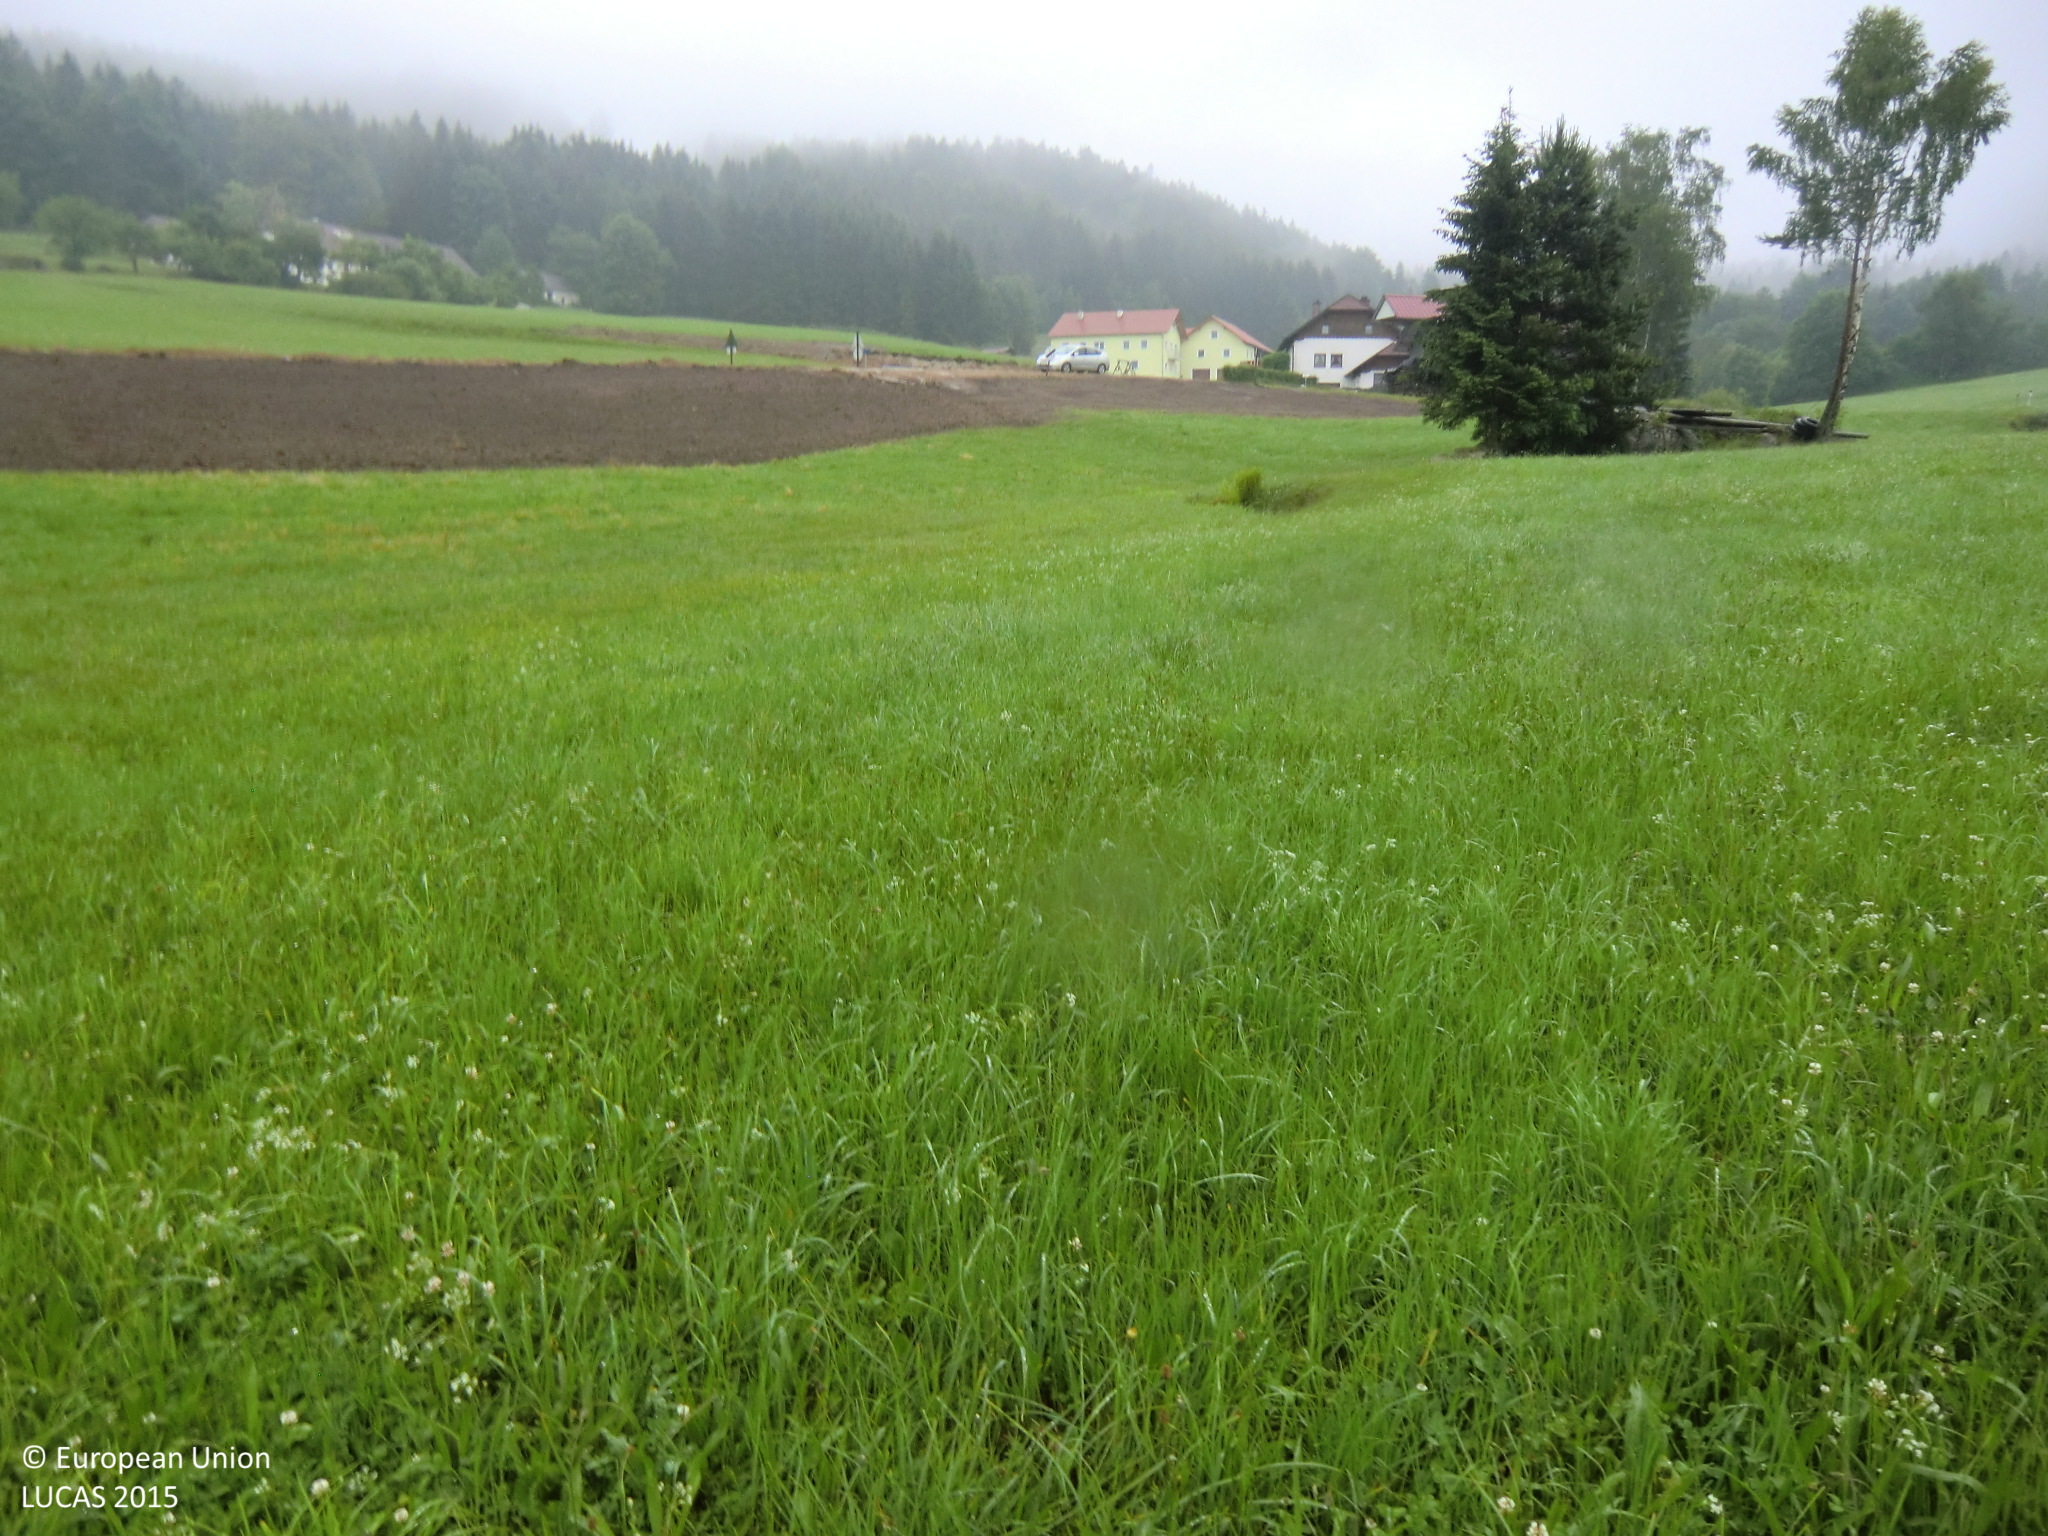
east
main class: Grassland
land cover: Grassland without tree/shrub cover
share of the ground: > 75 %
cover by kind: herbaceous plants 100 %
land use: Agriculture (excluding fallow land and kitchen gardens)
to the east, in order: Grassland without tree/shrub cover; Fences; Grassland without tree/shrub cover; Other bare soil; Paved roads, cycling and walking lanes; Grassland without tree/shrub cover; Paved roads, cycling and walking lanes; Grassland without tree/shrub cover; Apple fruit; Artificial constructions in urban areas
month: June
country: AT
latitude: 48.6142
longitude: 14.5992
